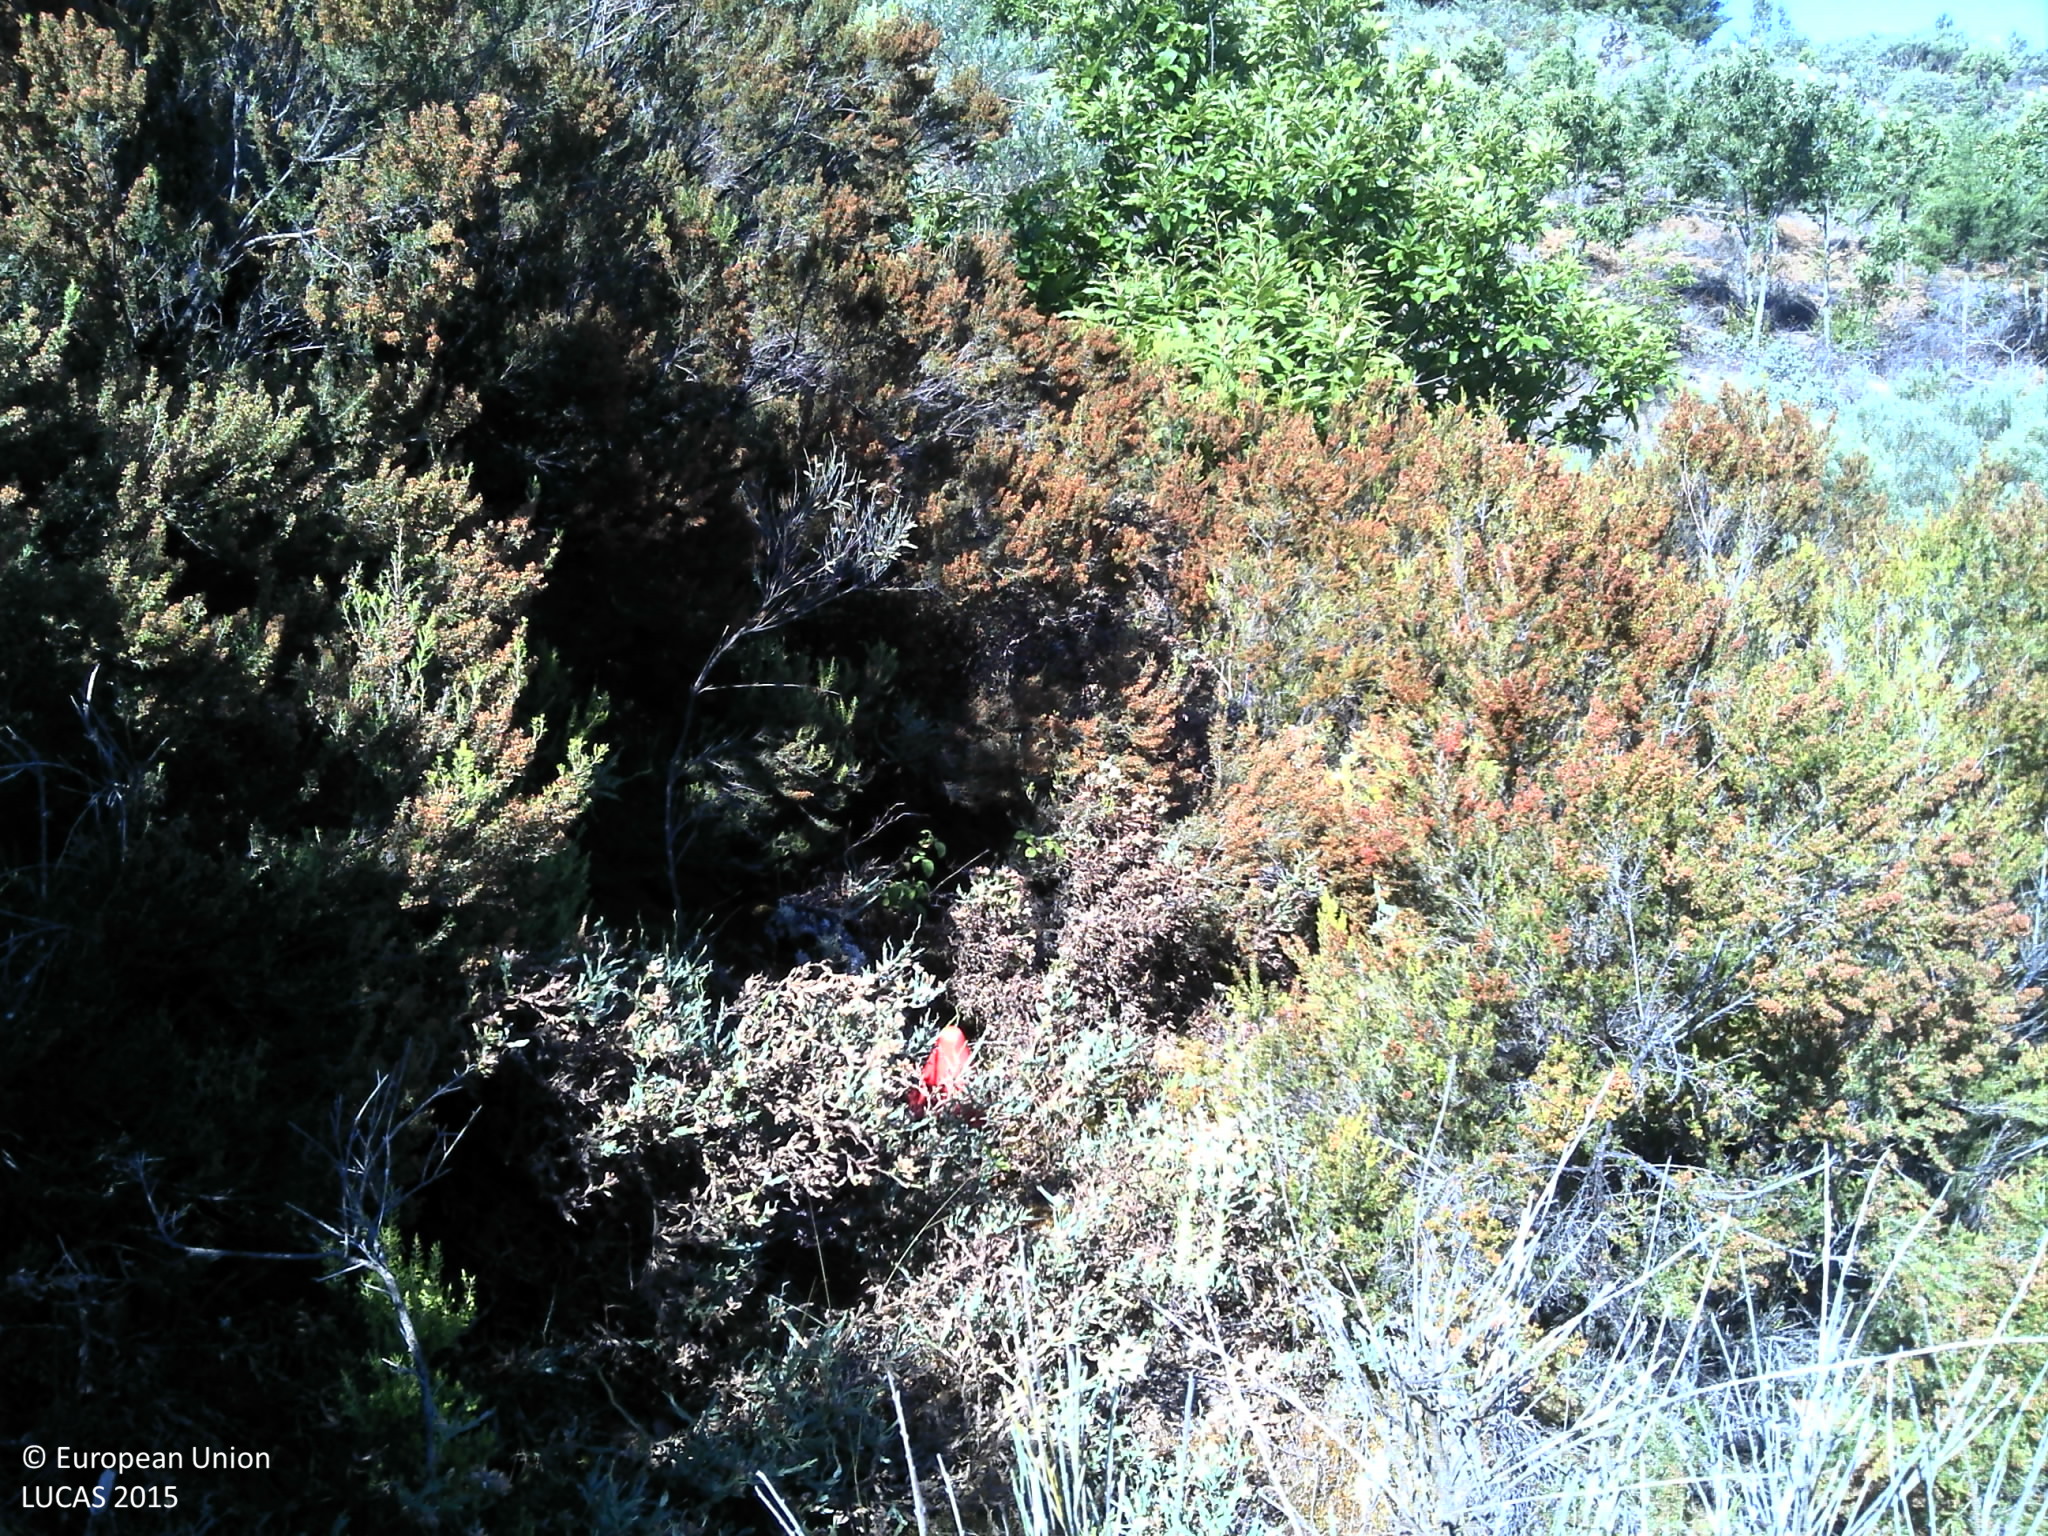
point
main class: Woodland
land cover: Broadleaved woodland
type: thermophilous deciduous forest
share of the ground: 10 - 25 %
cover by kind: shrubs 85 %, broadleaved forest trees 15 %
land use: Forestry
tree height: < 5 m
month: June
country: PT
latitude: 41.4381
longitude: -6.9270
